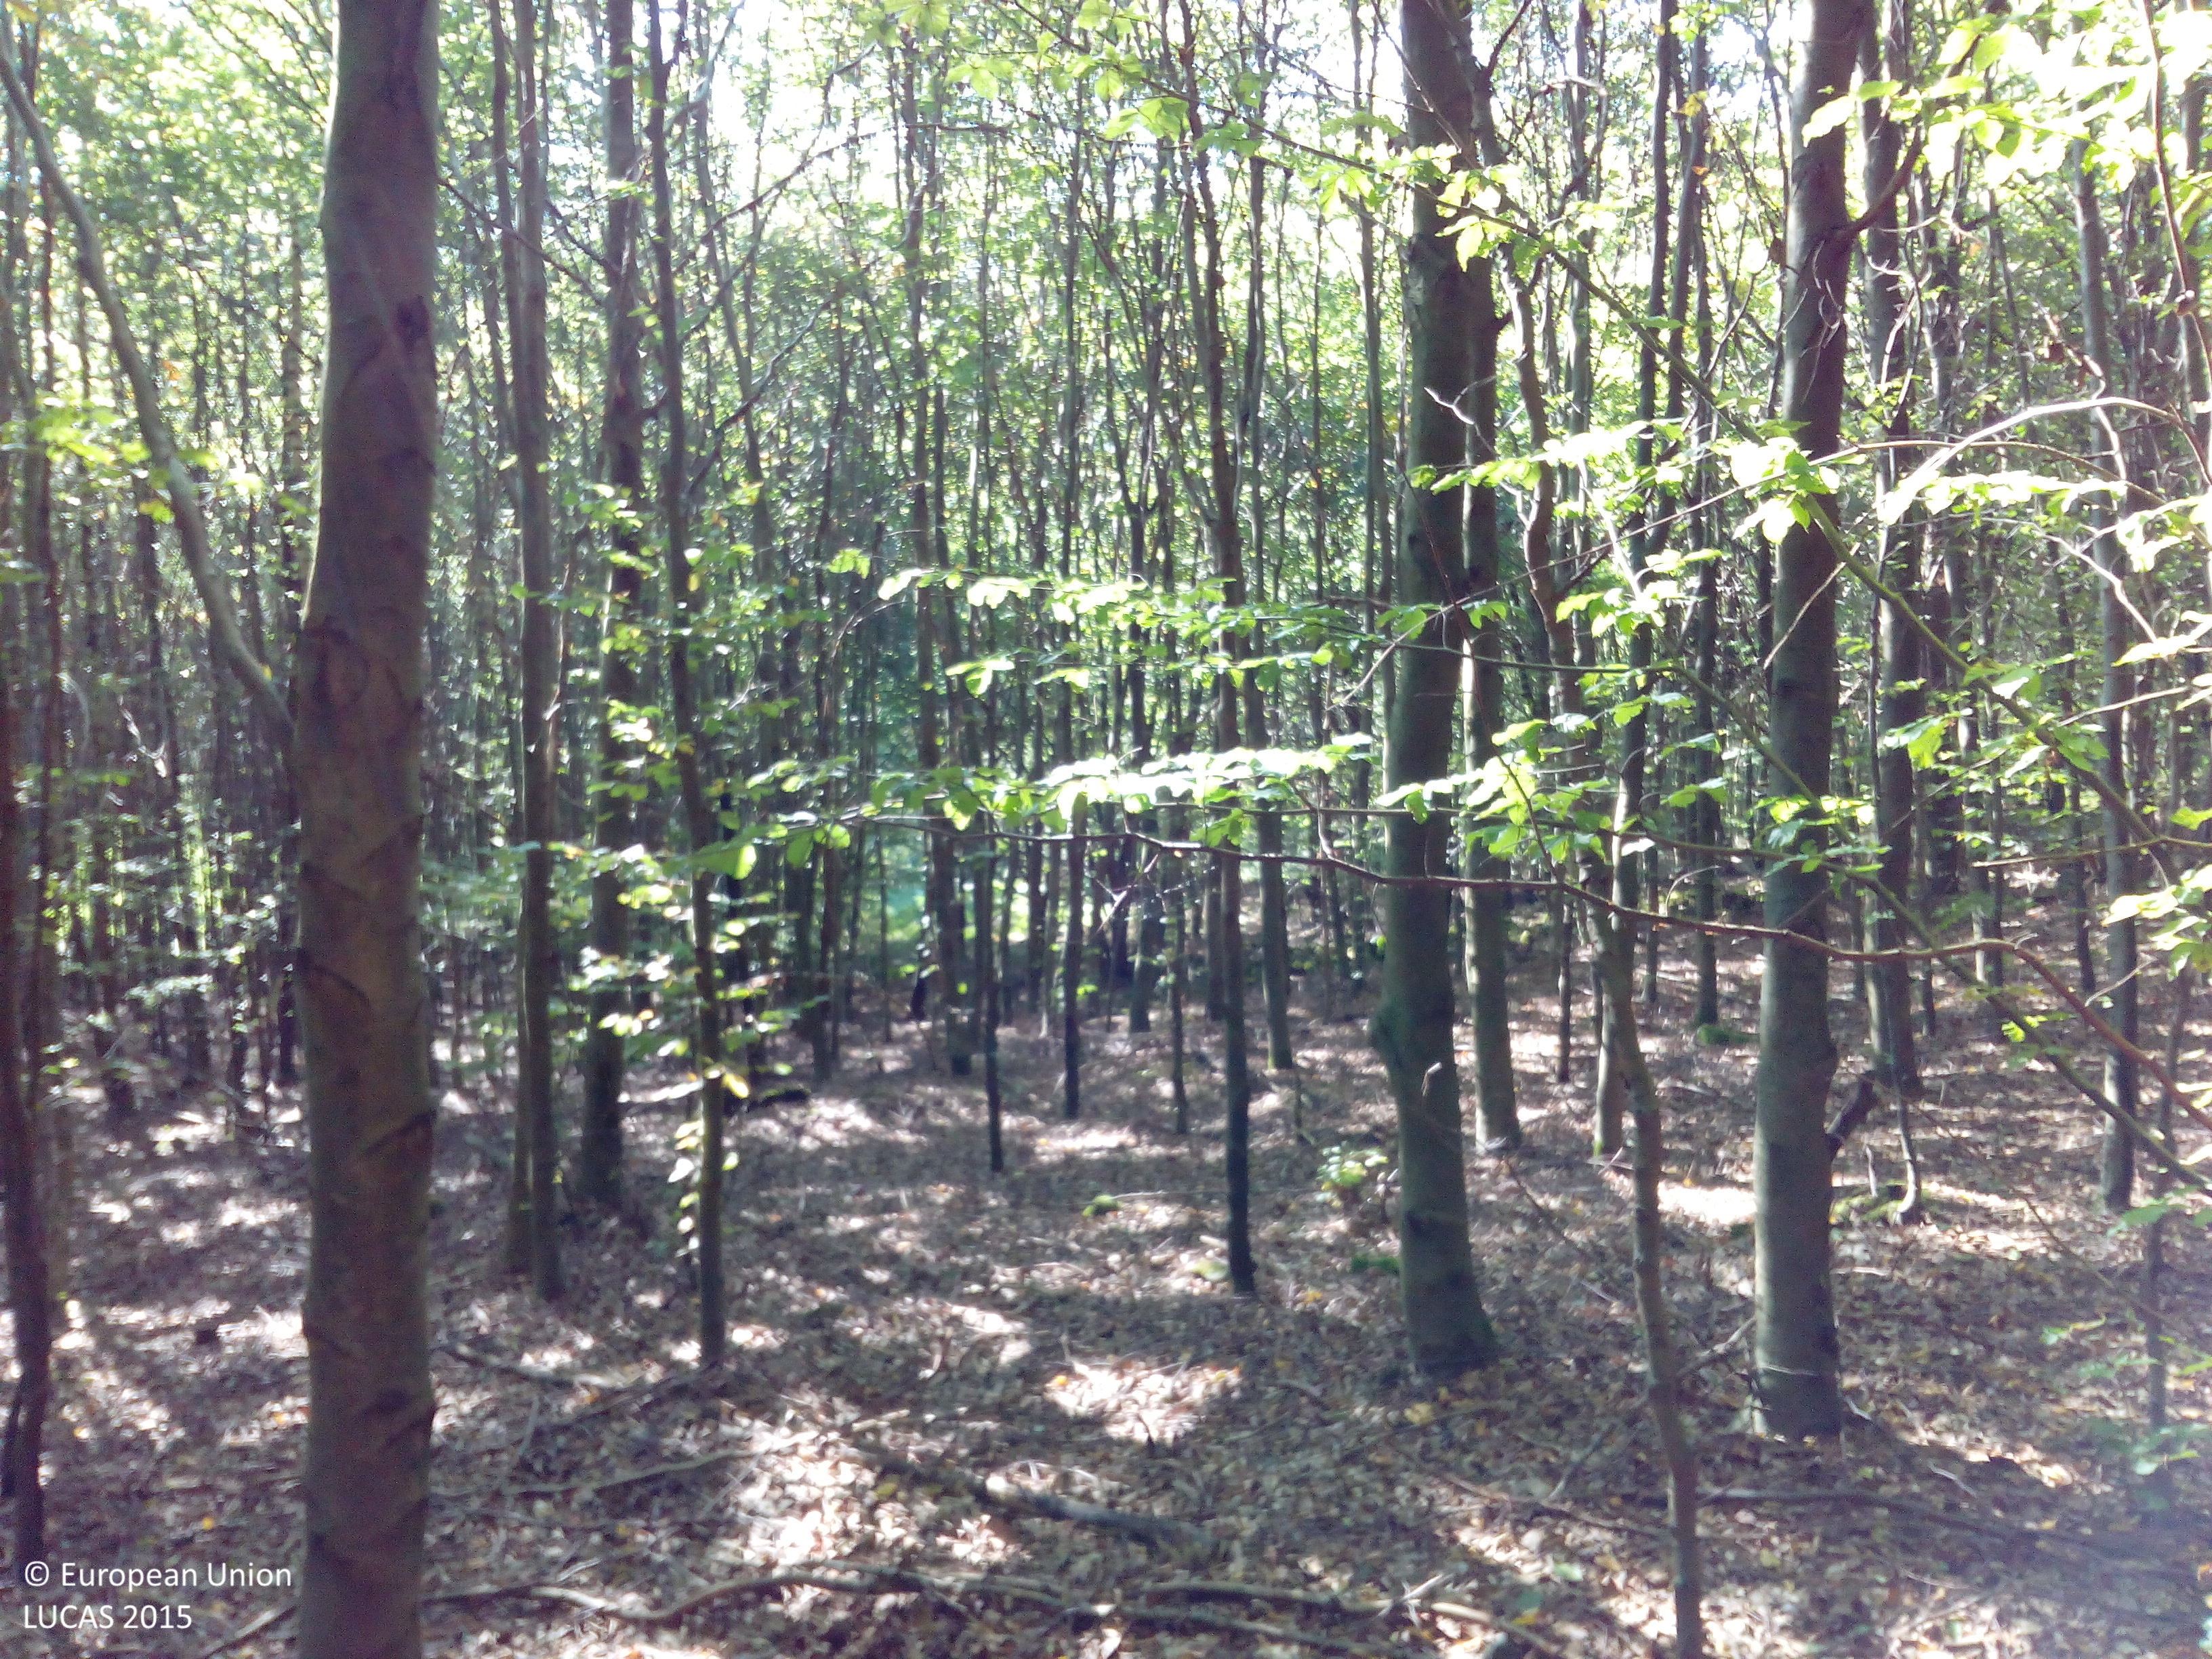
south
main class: Woodland
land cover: Broadleaved woodland
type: beech forest
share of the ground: > 75 %
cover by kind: broadleaved forest trees 90 %, unconsolidated bare surface 10 %
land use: Forestry
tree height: > 5 m
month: September
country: DE
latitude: 50.3071
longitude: 9.1718
